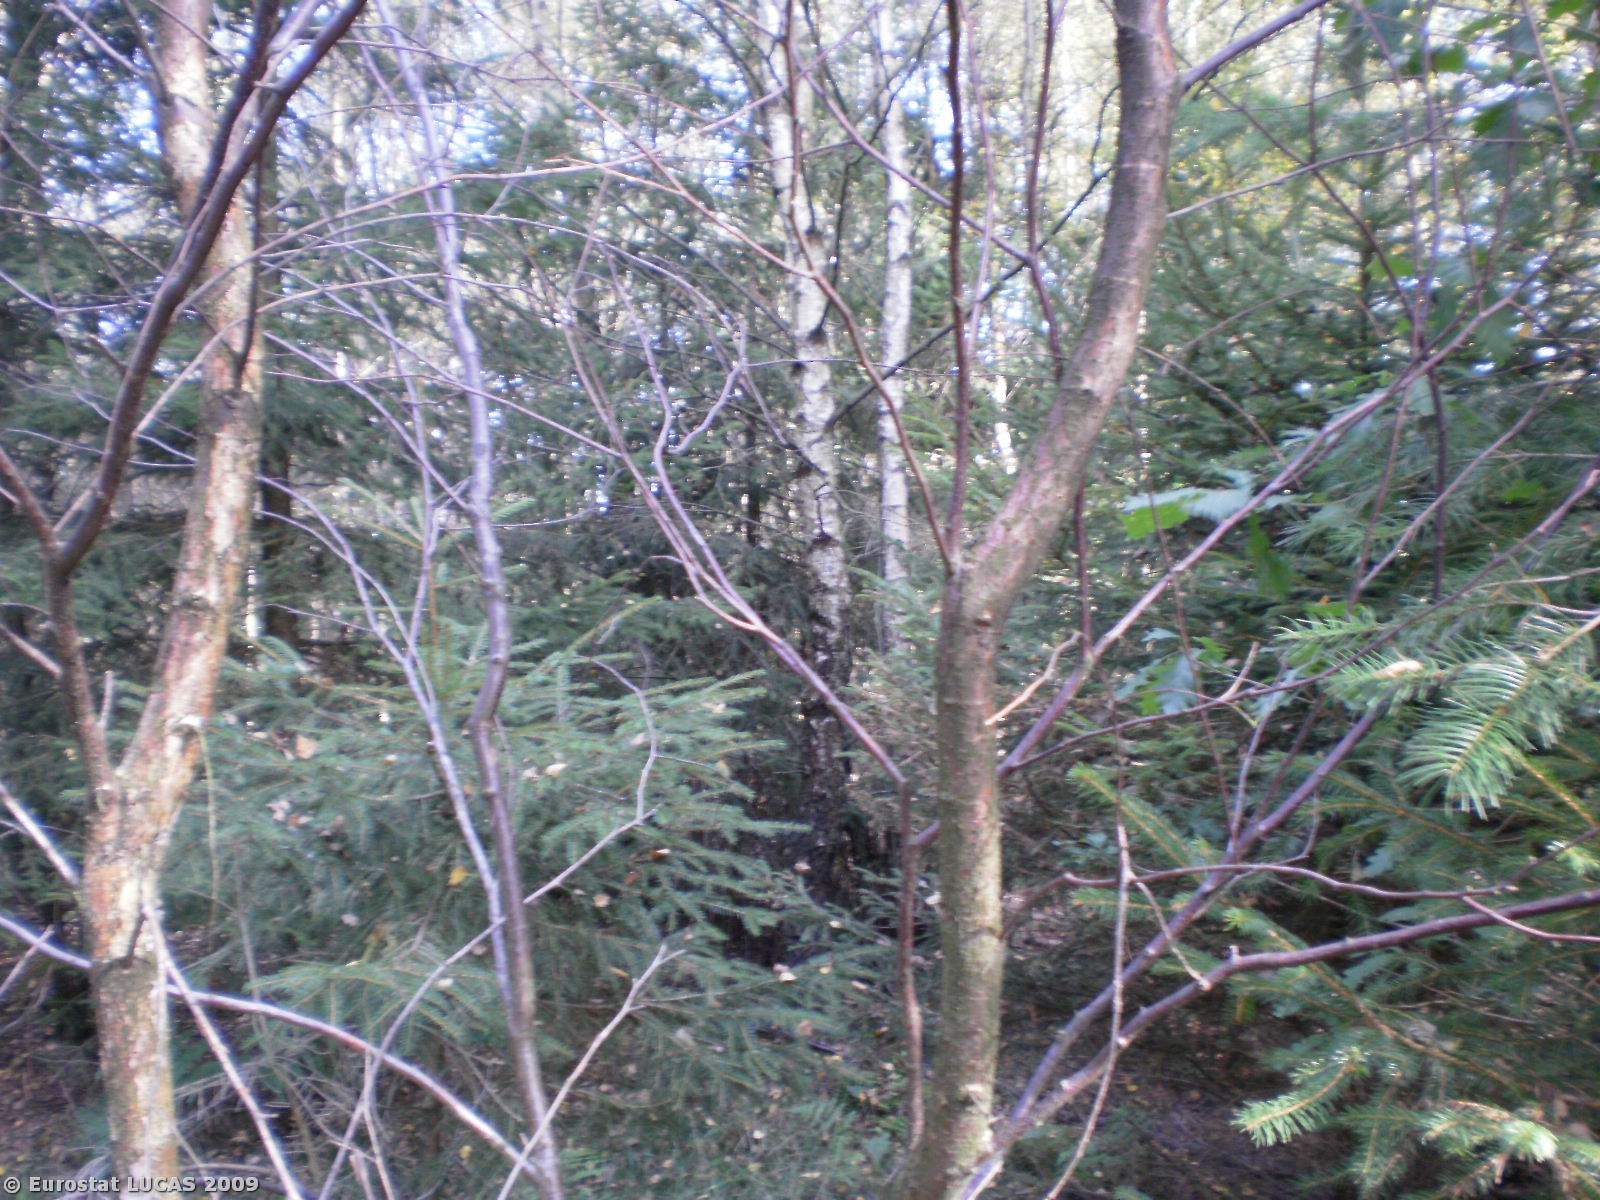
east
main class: Woodland
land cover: Mixed woodland
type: beech forest
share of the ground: > 75 %
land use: Forestry
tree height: > 5 m
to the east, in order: Mixed woodland; Ditches and canals; Grass margins; Tracks; Grass margins; Ditches and canals; Mixed woodland; Coniferous woodland
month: September
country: BE
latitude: 50.3026
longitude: 6.2508
